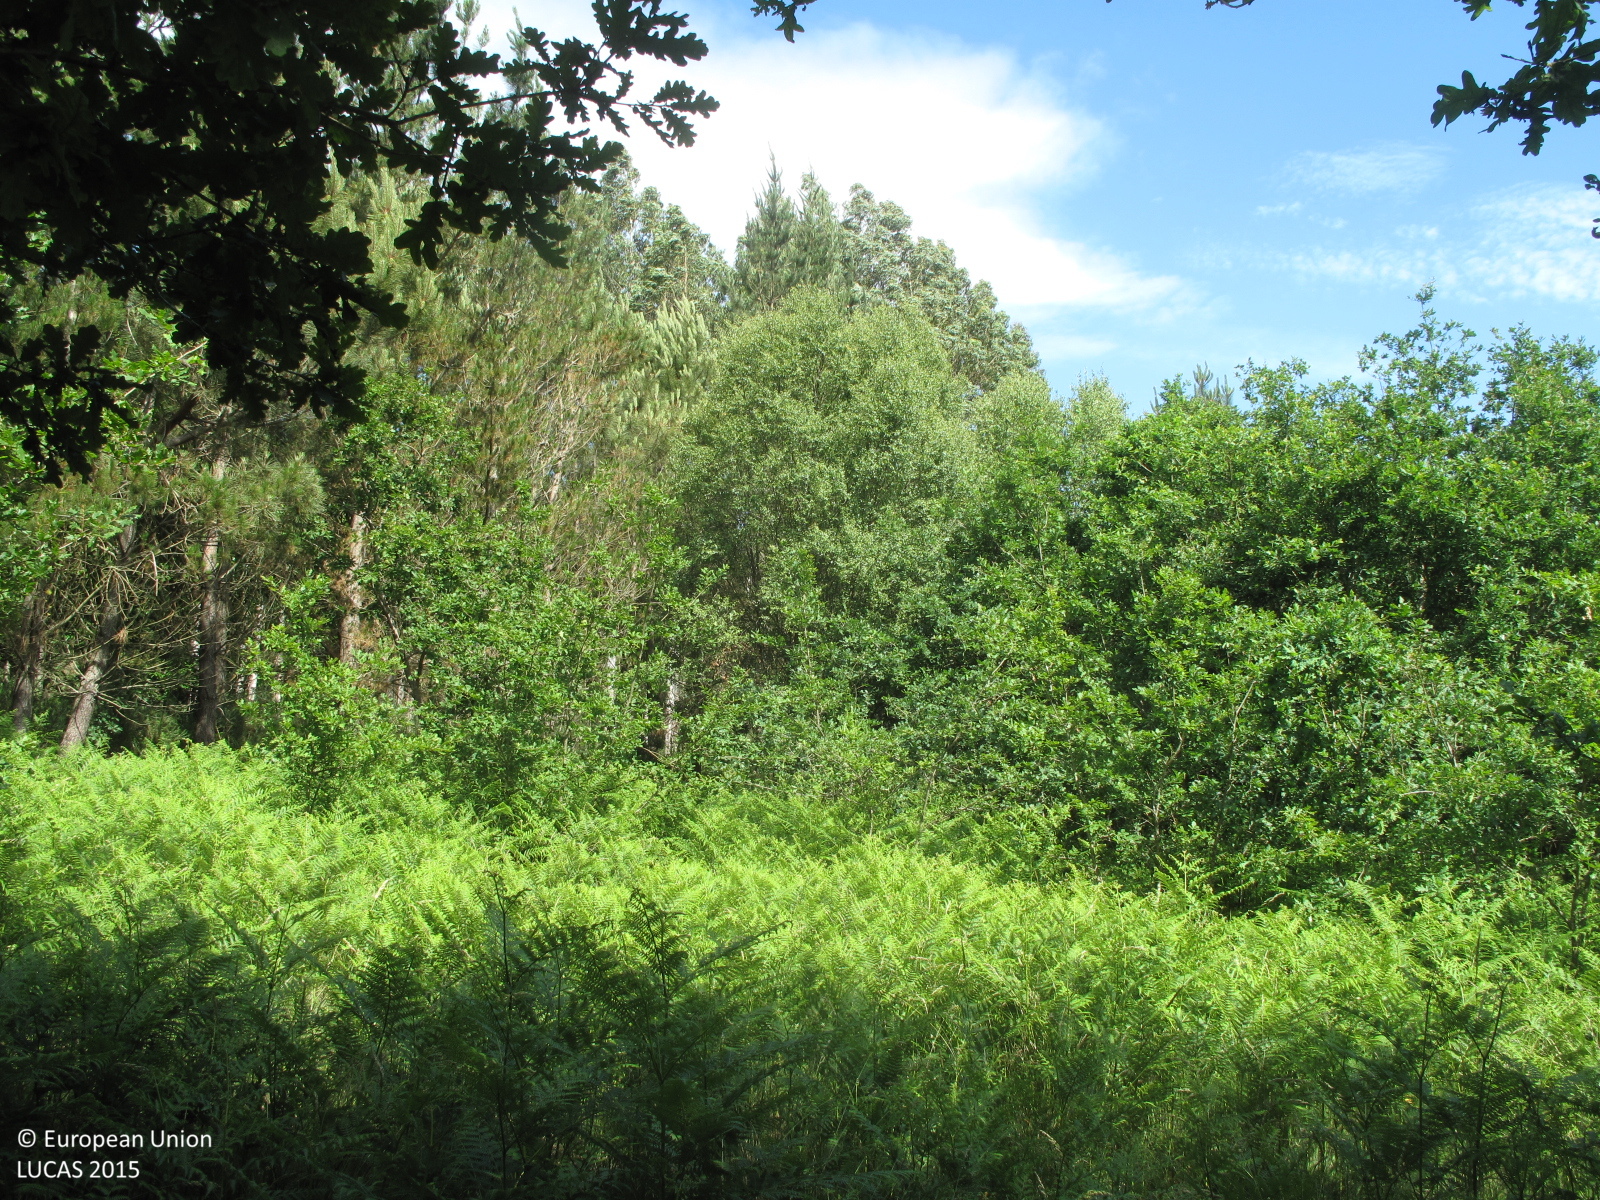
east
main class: Woodland
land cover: Broadleaved woodland
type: acidophilous oak and oak-birch forest
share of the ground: 25 - 50 %
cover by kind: herbaceous plants 60 %, broadleaved forest trees 30 %, shrubs 10 %
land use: Forestry
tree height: > 5 m
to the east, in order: Broadleaved woodland; Shrubland with sparse tree cover; Electric lines; Shrubland with sparse tree cover; Broadleaved woodland; Pine dominated coniferous woodland; Broadleaved woodland; Pine dominated coniferous woodland; Broadleaved woodland
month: June
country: ES
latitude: 42.9504
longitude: -8.4767
